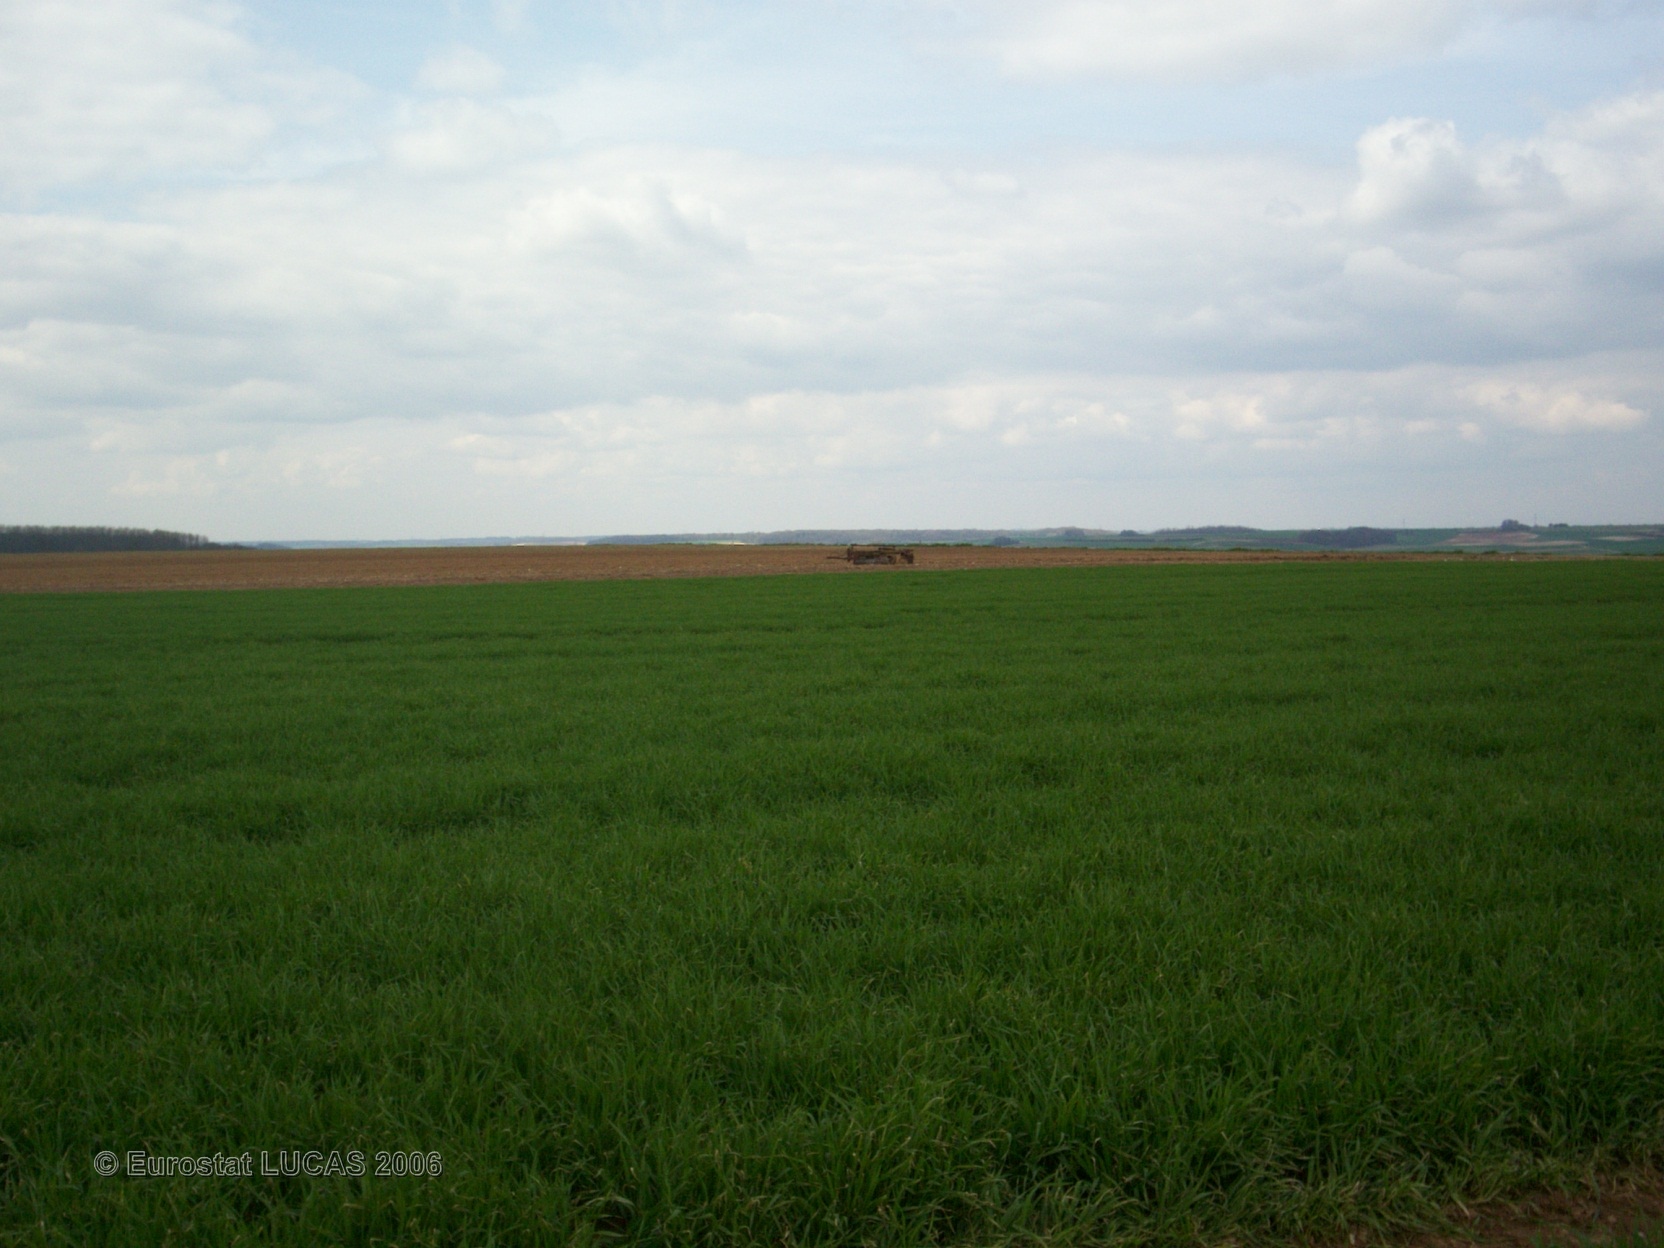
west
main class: Cropland
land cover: Common wheat
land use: Agriculture (excluding fallow land and kitchen gardens)
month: April
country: FR
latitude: 50.0144
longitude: 2.5778
